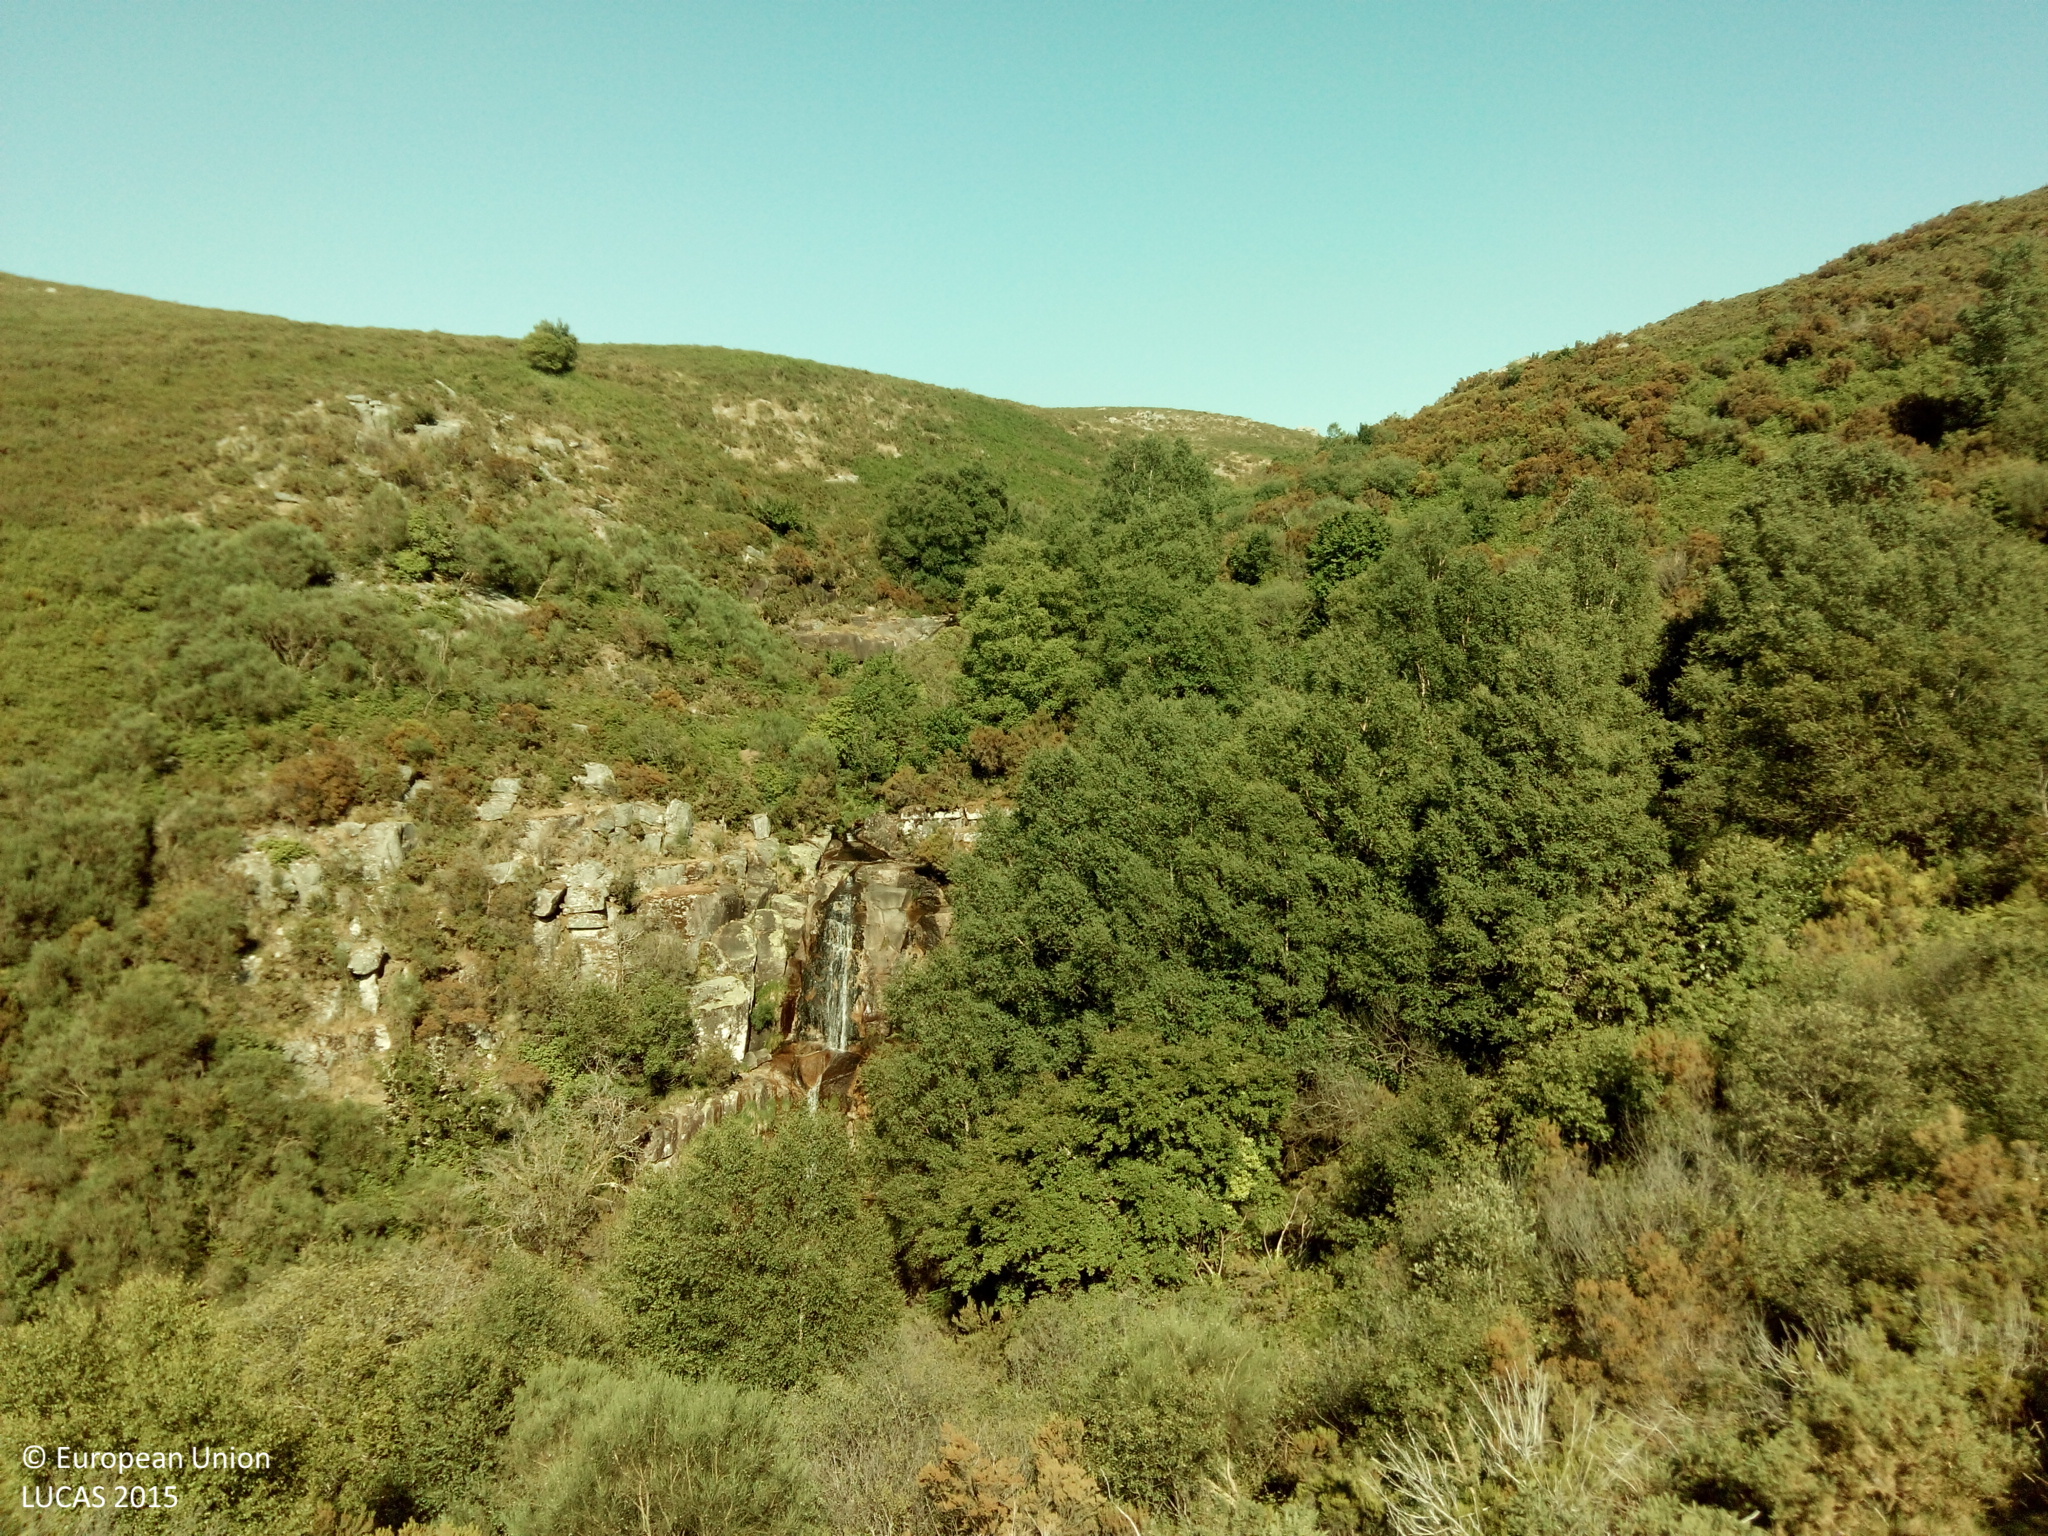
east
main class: Shrubland
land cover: Shrubland with sparse tree cover
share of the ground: > 75 %
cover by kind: shrubs 95 %, broadleaved forest trees 5 %
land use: Semi-natural and natural areas not in use
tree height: > 5 m
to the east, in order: Shrubland with sparse tree cover; Rock outcrops; Shrubland with sparse tree cover; Rock outcrops
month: June
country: ES
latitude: 42.3440
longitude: -8.3600
